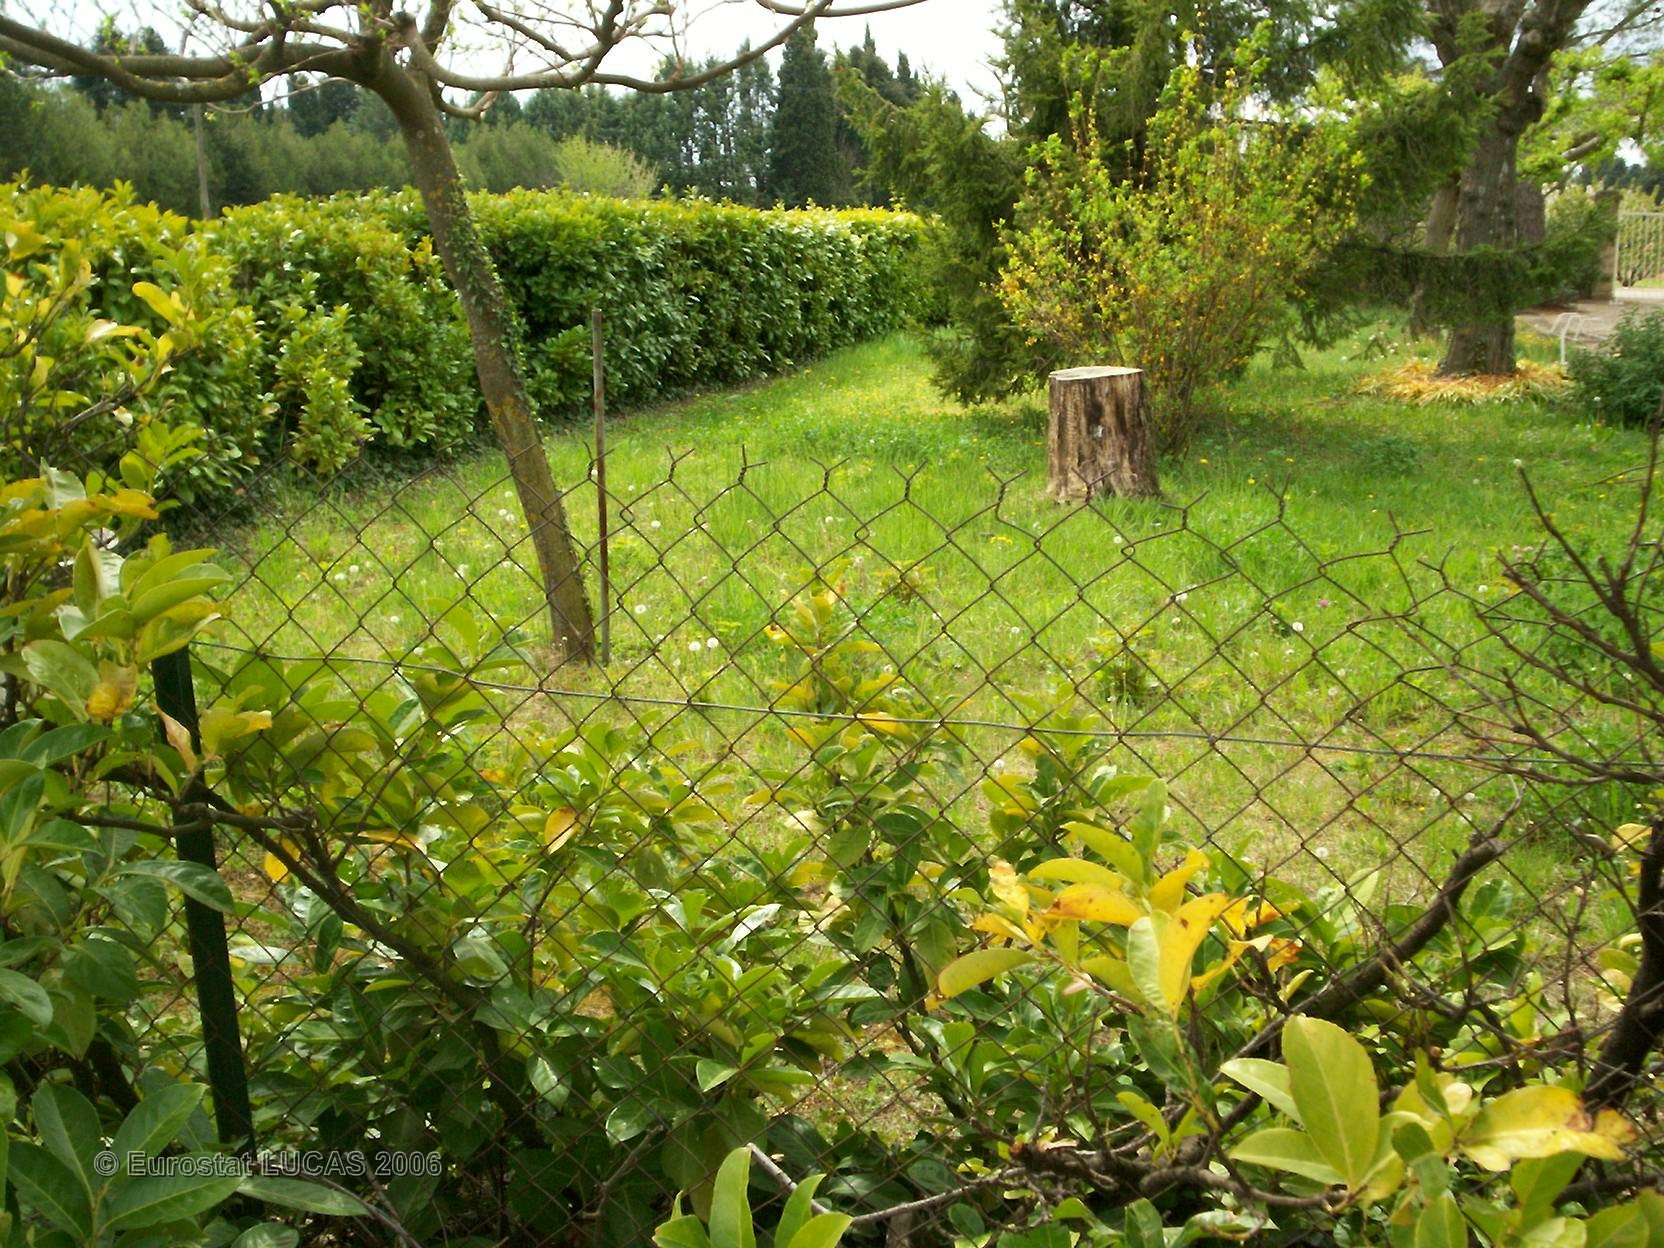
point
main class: Grassland
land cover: Grassland with sparse tree/shrub cover
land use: Residential
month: April
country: FR
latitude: 43.8144
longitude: 4.9988
